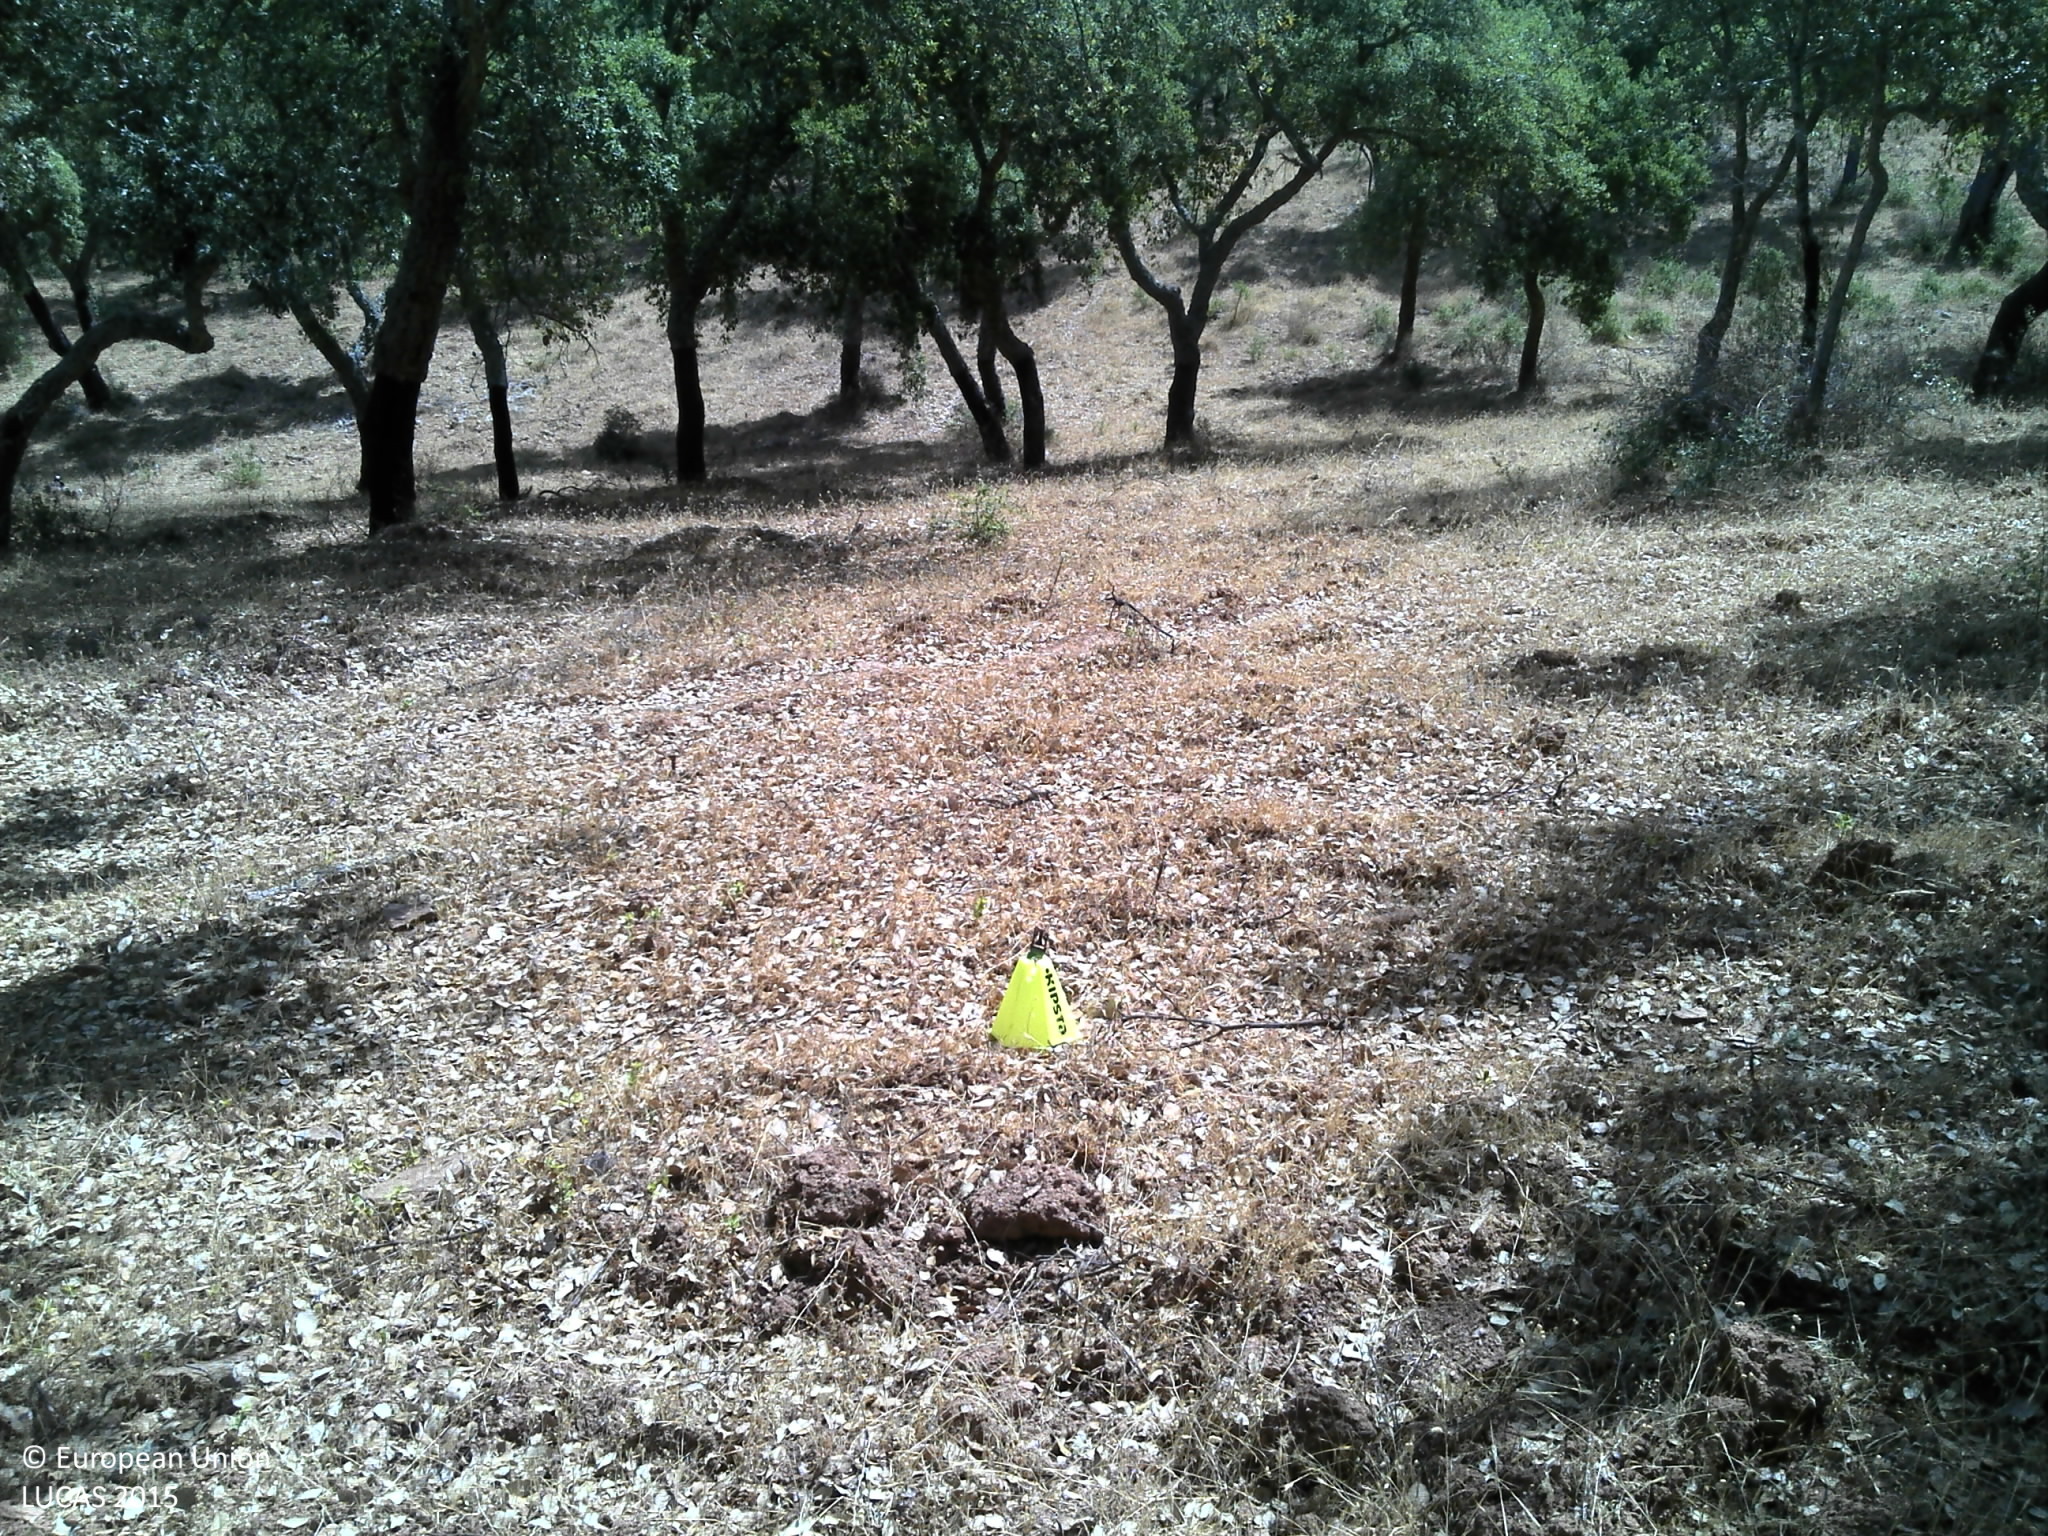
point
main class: Woodland
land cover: Broadleaved woodland
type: broadleaved evergreen forest
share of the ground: > 75 %
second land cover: Grassland without tree/shrub cover
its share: 25 - 50 %
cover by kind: broadleaved forest trees 75 %, herbaceous plants 20 %, shrubs 5 %
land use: Forestry
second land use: Agriculture (excluding fallow land and kitchen gardens)
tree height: > 5 m
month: July
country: PT
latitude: 38.2633
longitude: -7.7564
